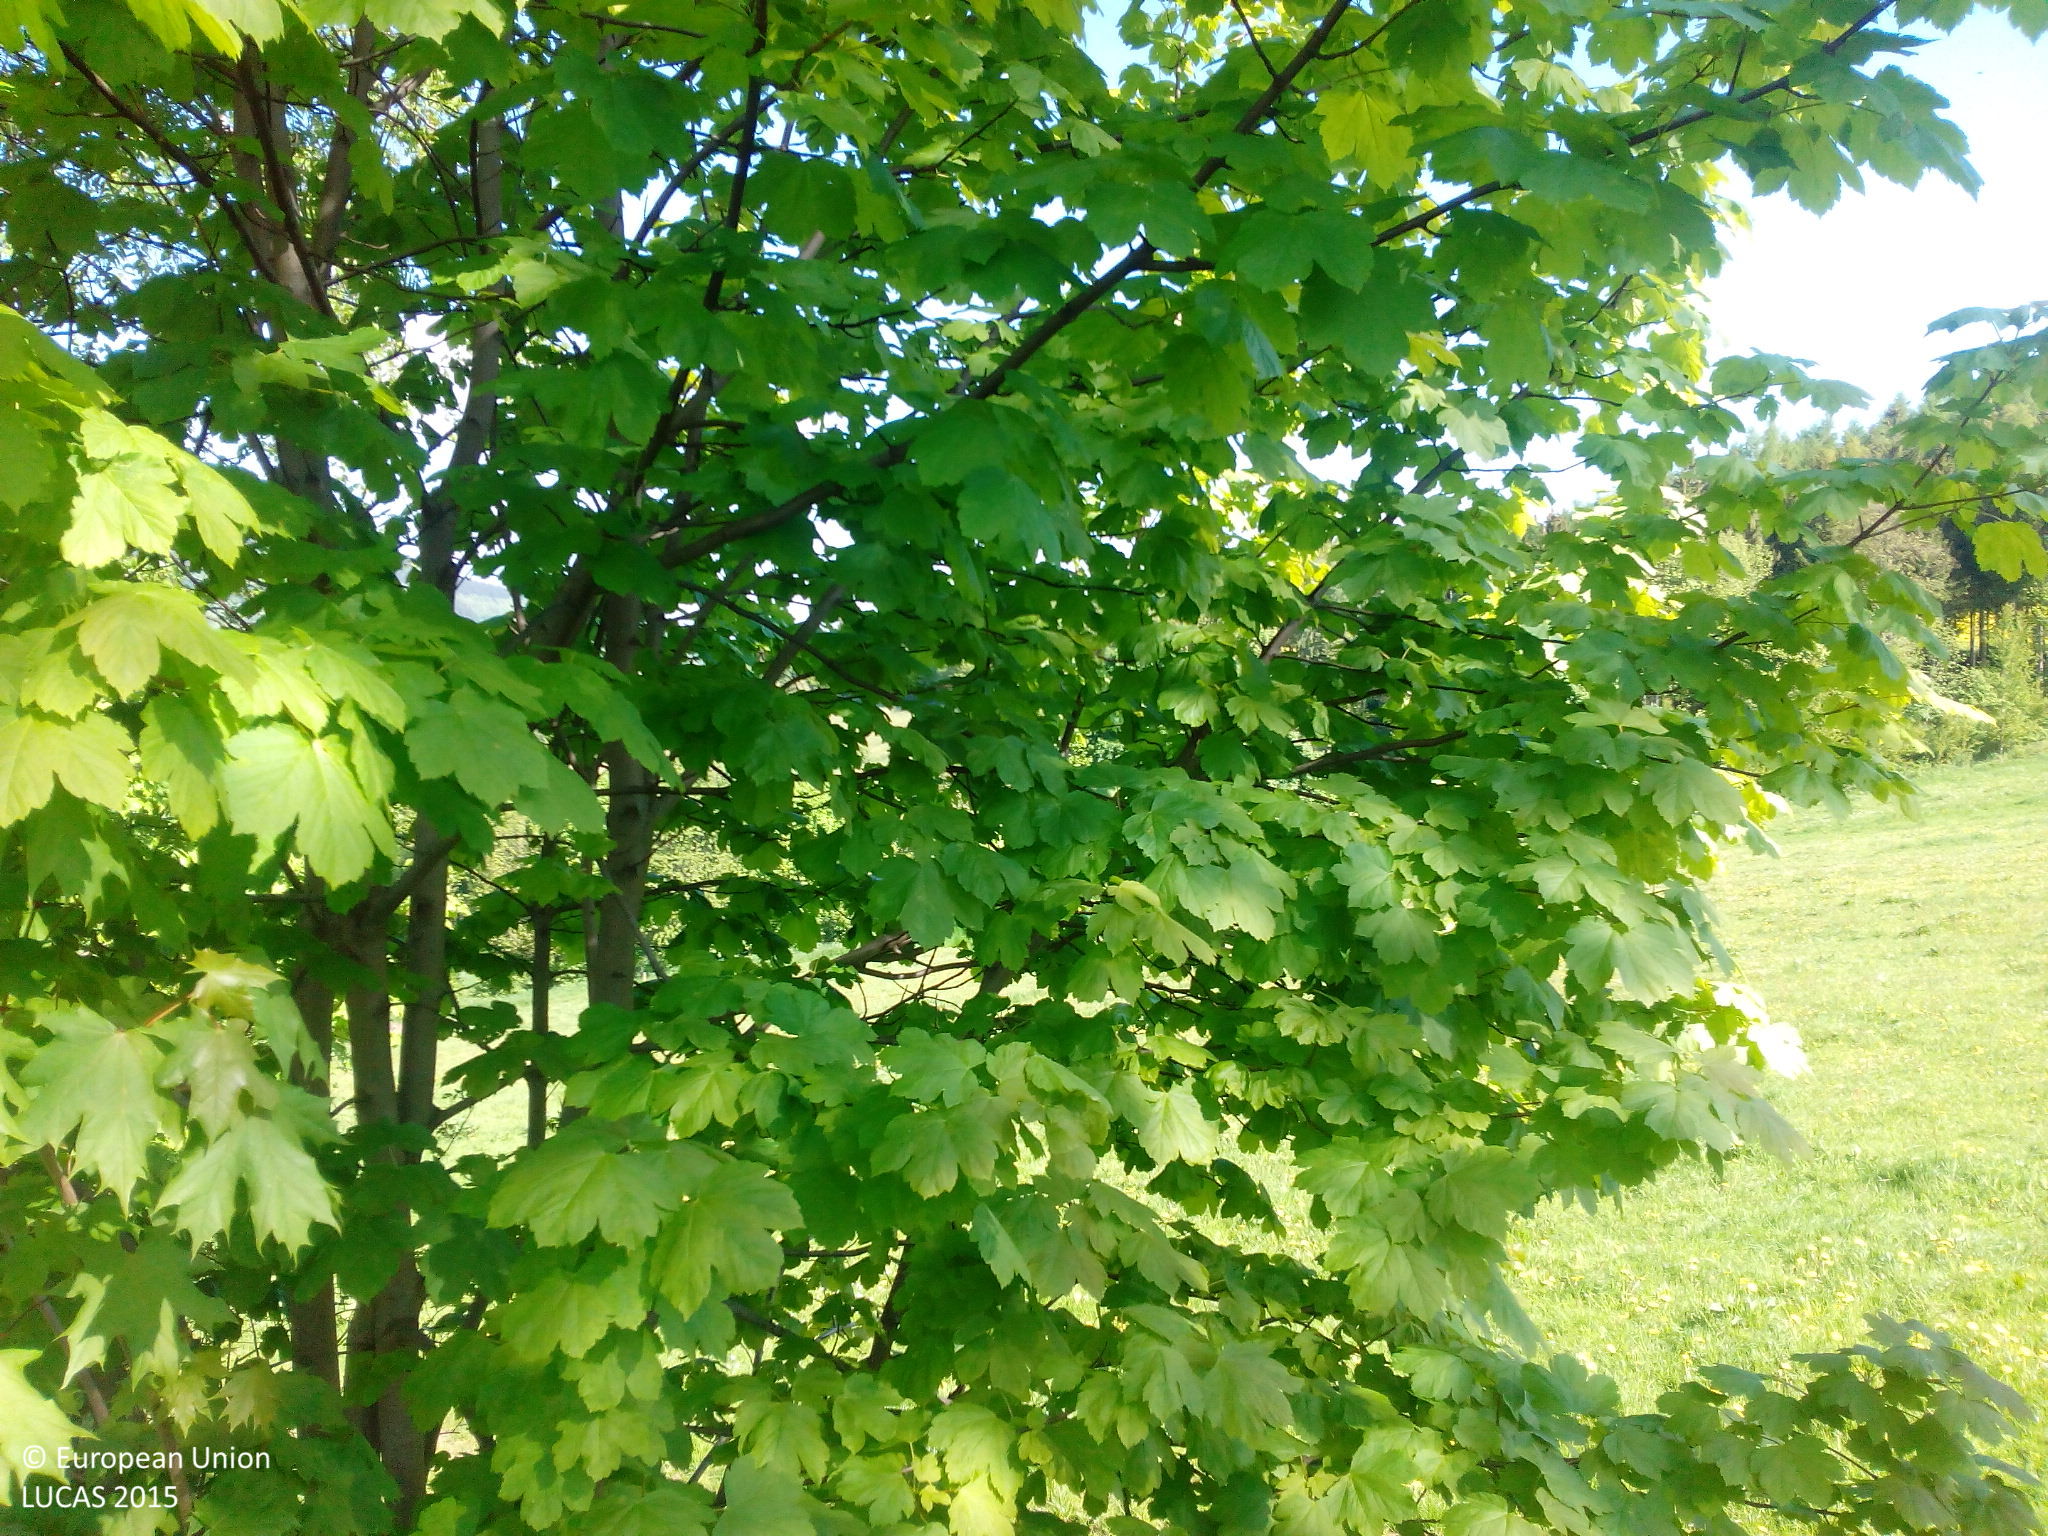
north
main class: Grassland
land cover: Grassland without tree/shrub cover
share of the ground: > 75 %
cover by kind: herbaceous plants 100 %
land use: Agriculture (excluding fallow land and kitchen gardens)
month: May
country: DE
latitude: 50.5570
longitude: 13.0631
